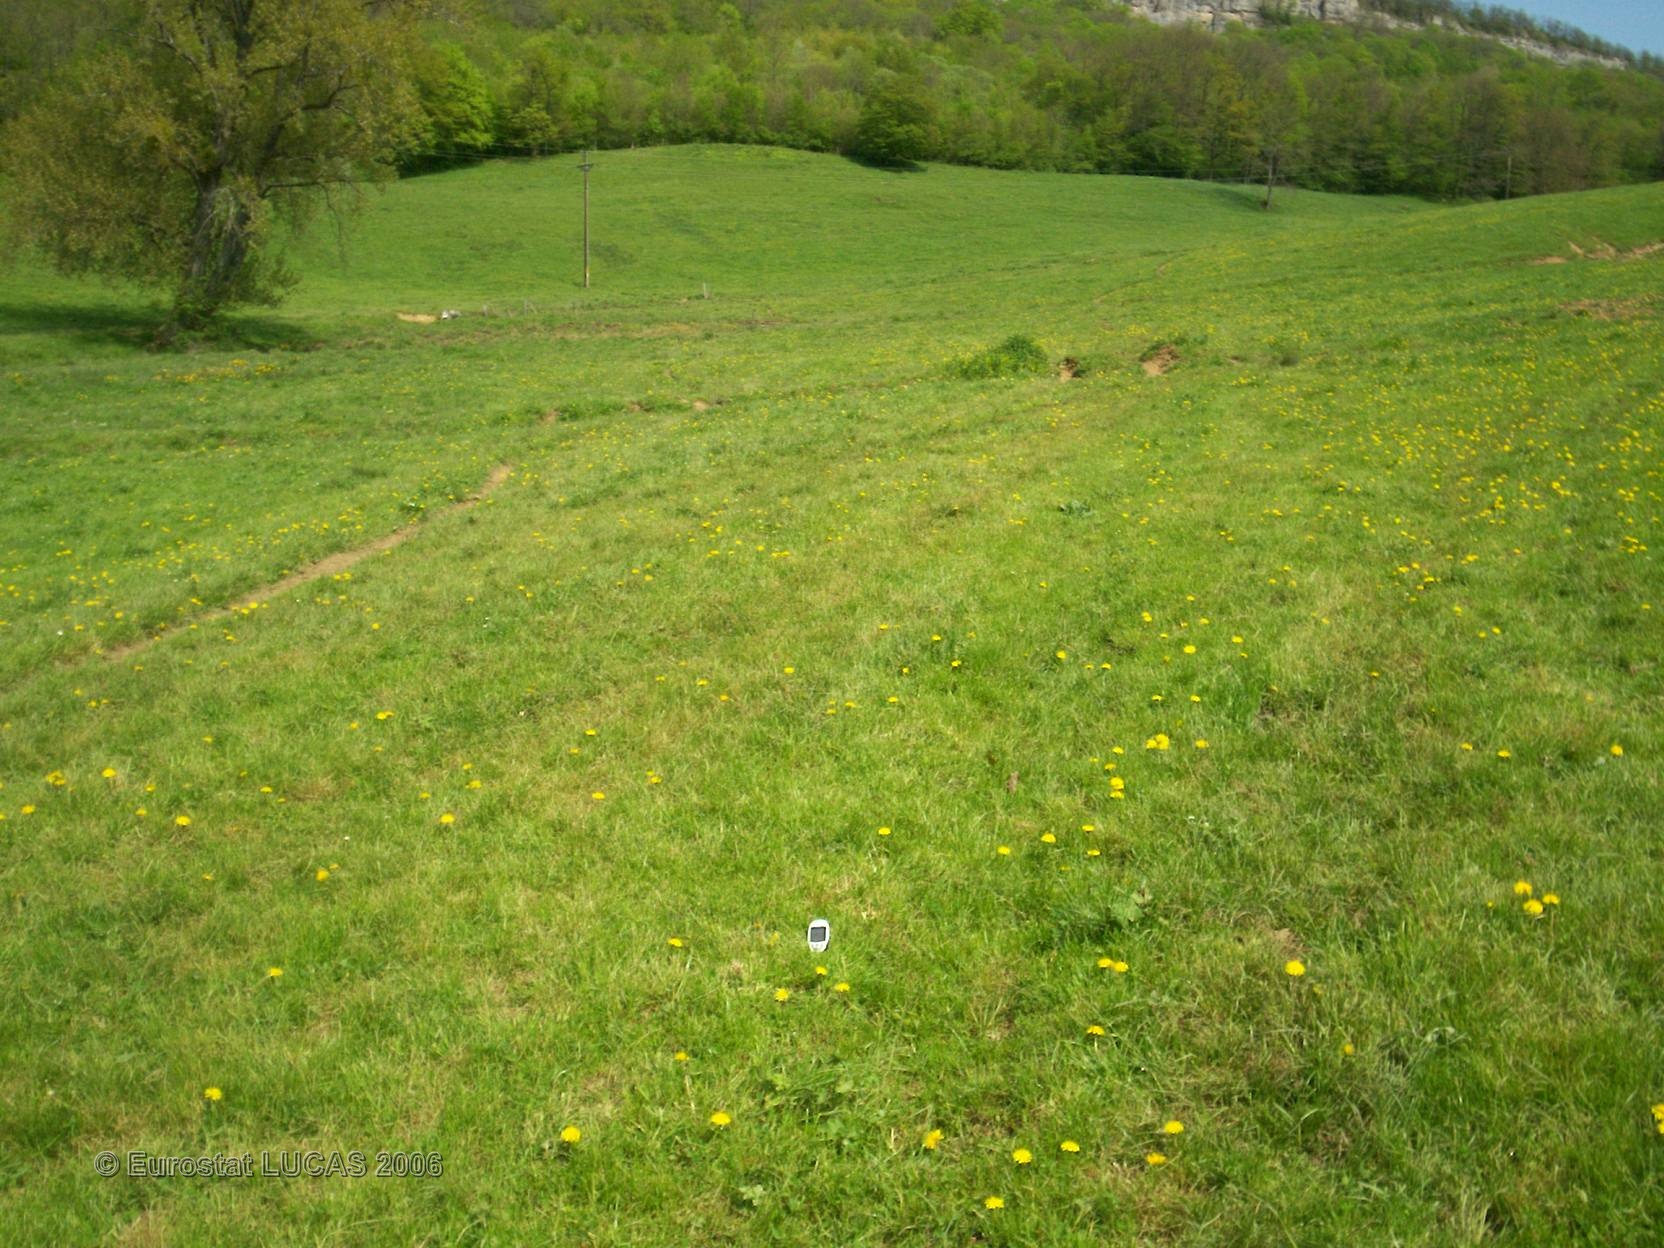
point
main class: Grassland
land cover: Grassland without tree/shrub cover
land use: Agriculture (excluding fallow land and kitchen gardens)
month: May
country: FR
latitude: 47.4779
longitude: 4.5986
